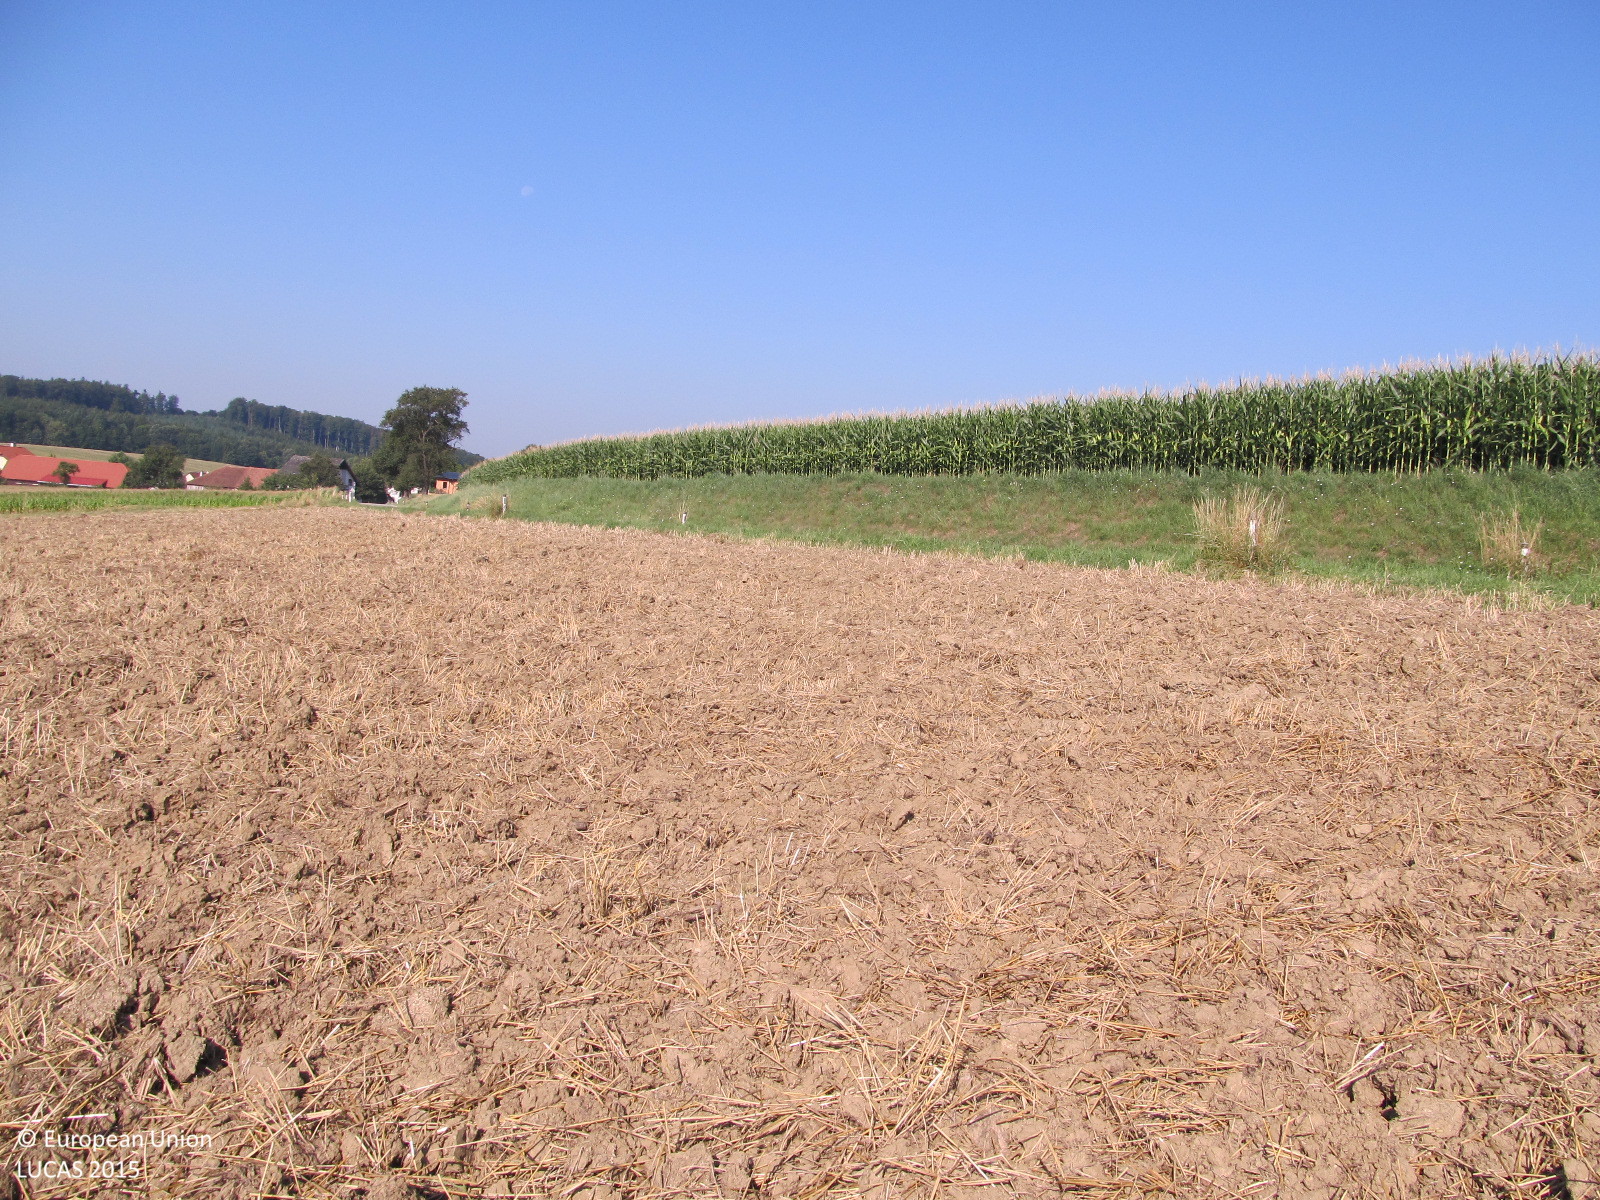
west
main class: Cropland
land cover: Common wheat
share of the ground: 10 - 25 %
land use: Agriculture (excluding fallow land and kitchen gardens)
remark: Harvested field
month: August
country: AT
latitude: 48.2136
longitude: 15.8306
